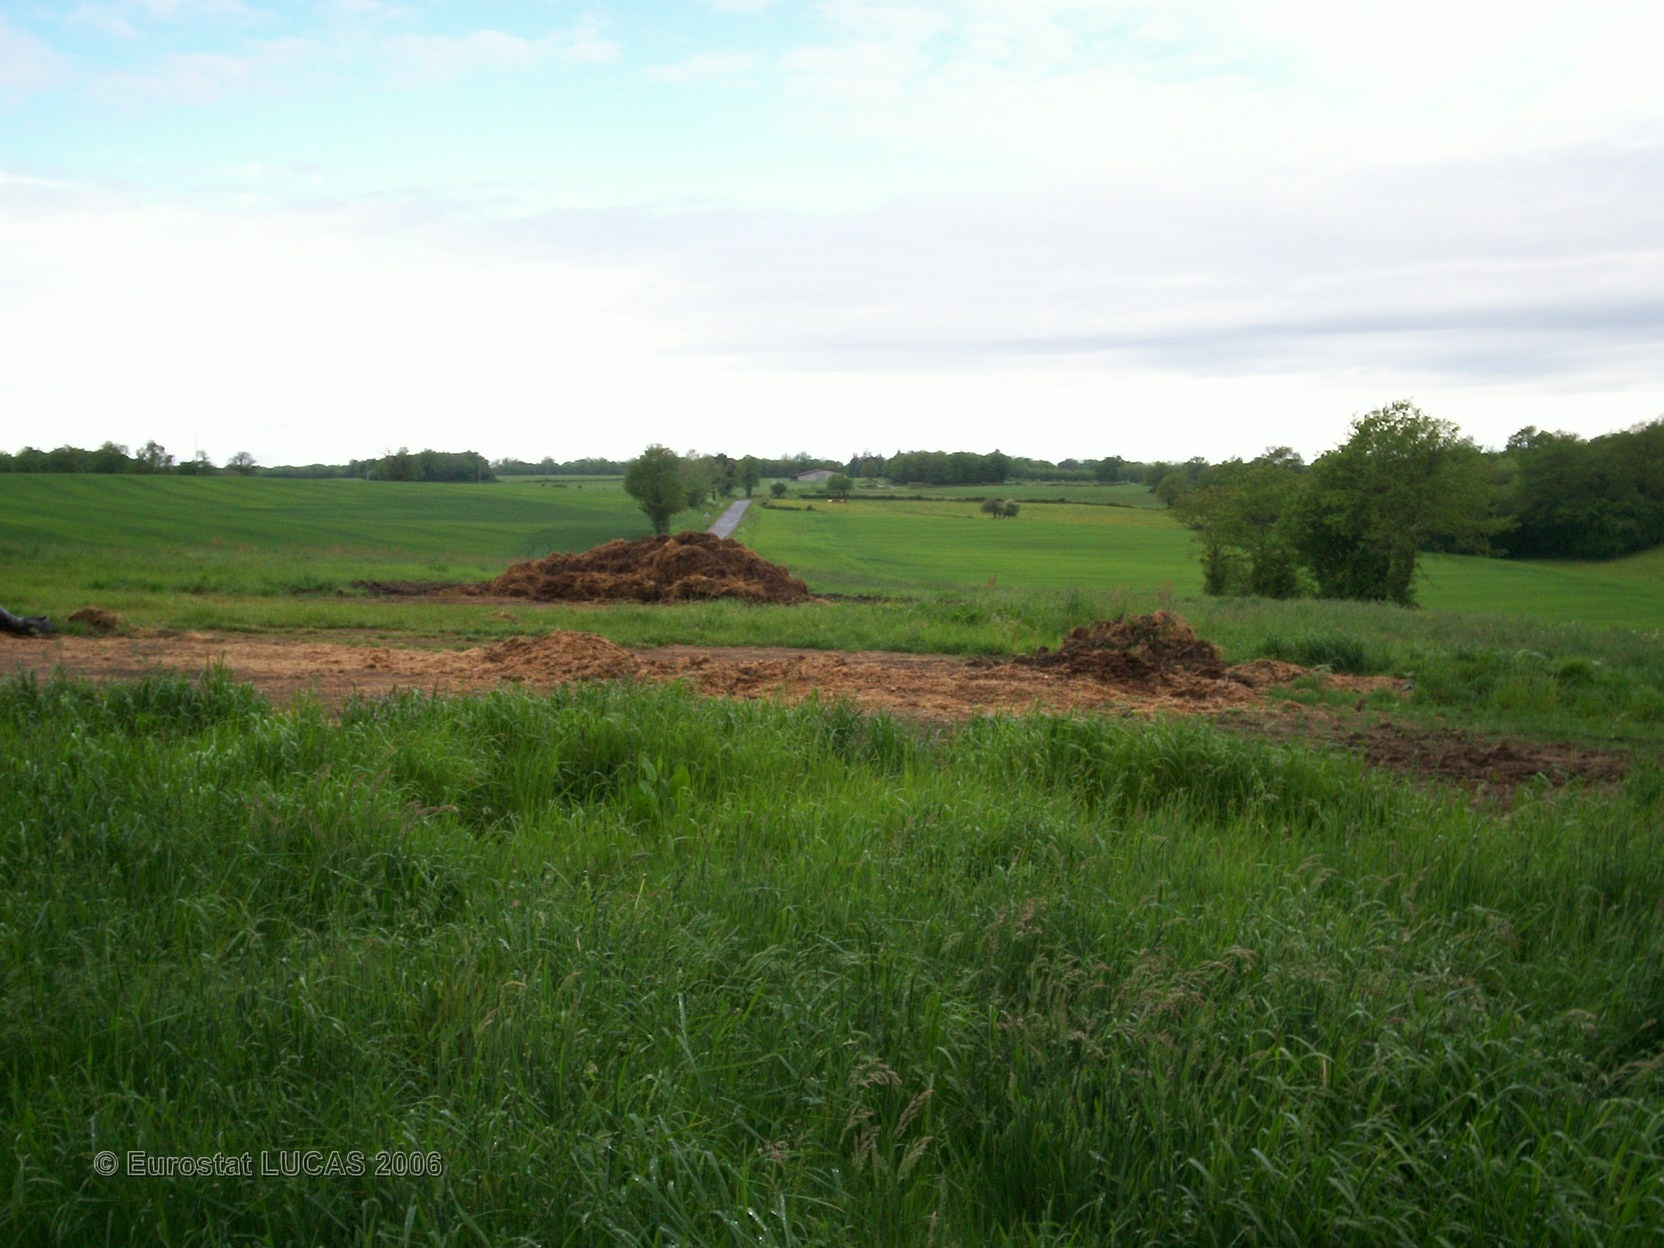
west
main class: Grassland
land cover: Grassland without tree/shrub cover
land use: Logistics and storage
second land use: Agriculture (excluding fallow land and kitchen gardens)
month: May
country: FR
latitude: 46.0306
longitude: 0.4365
